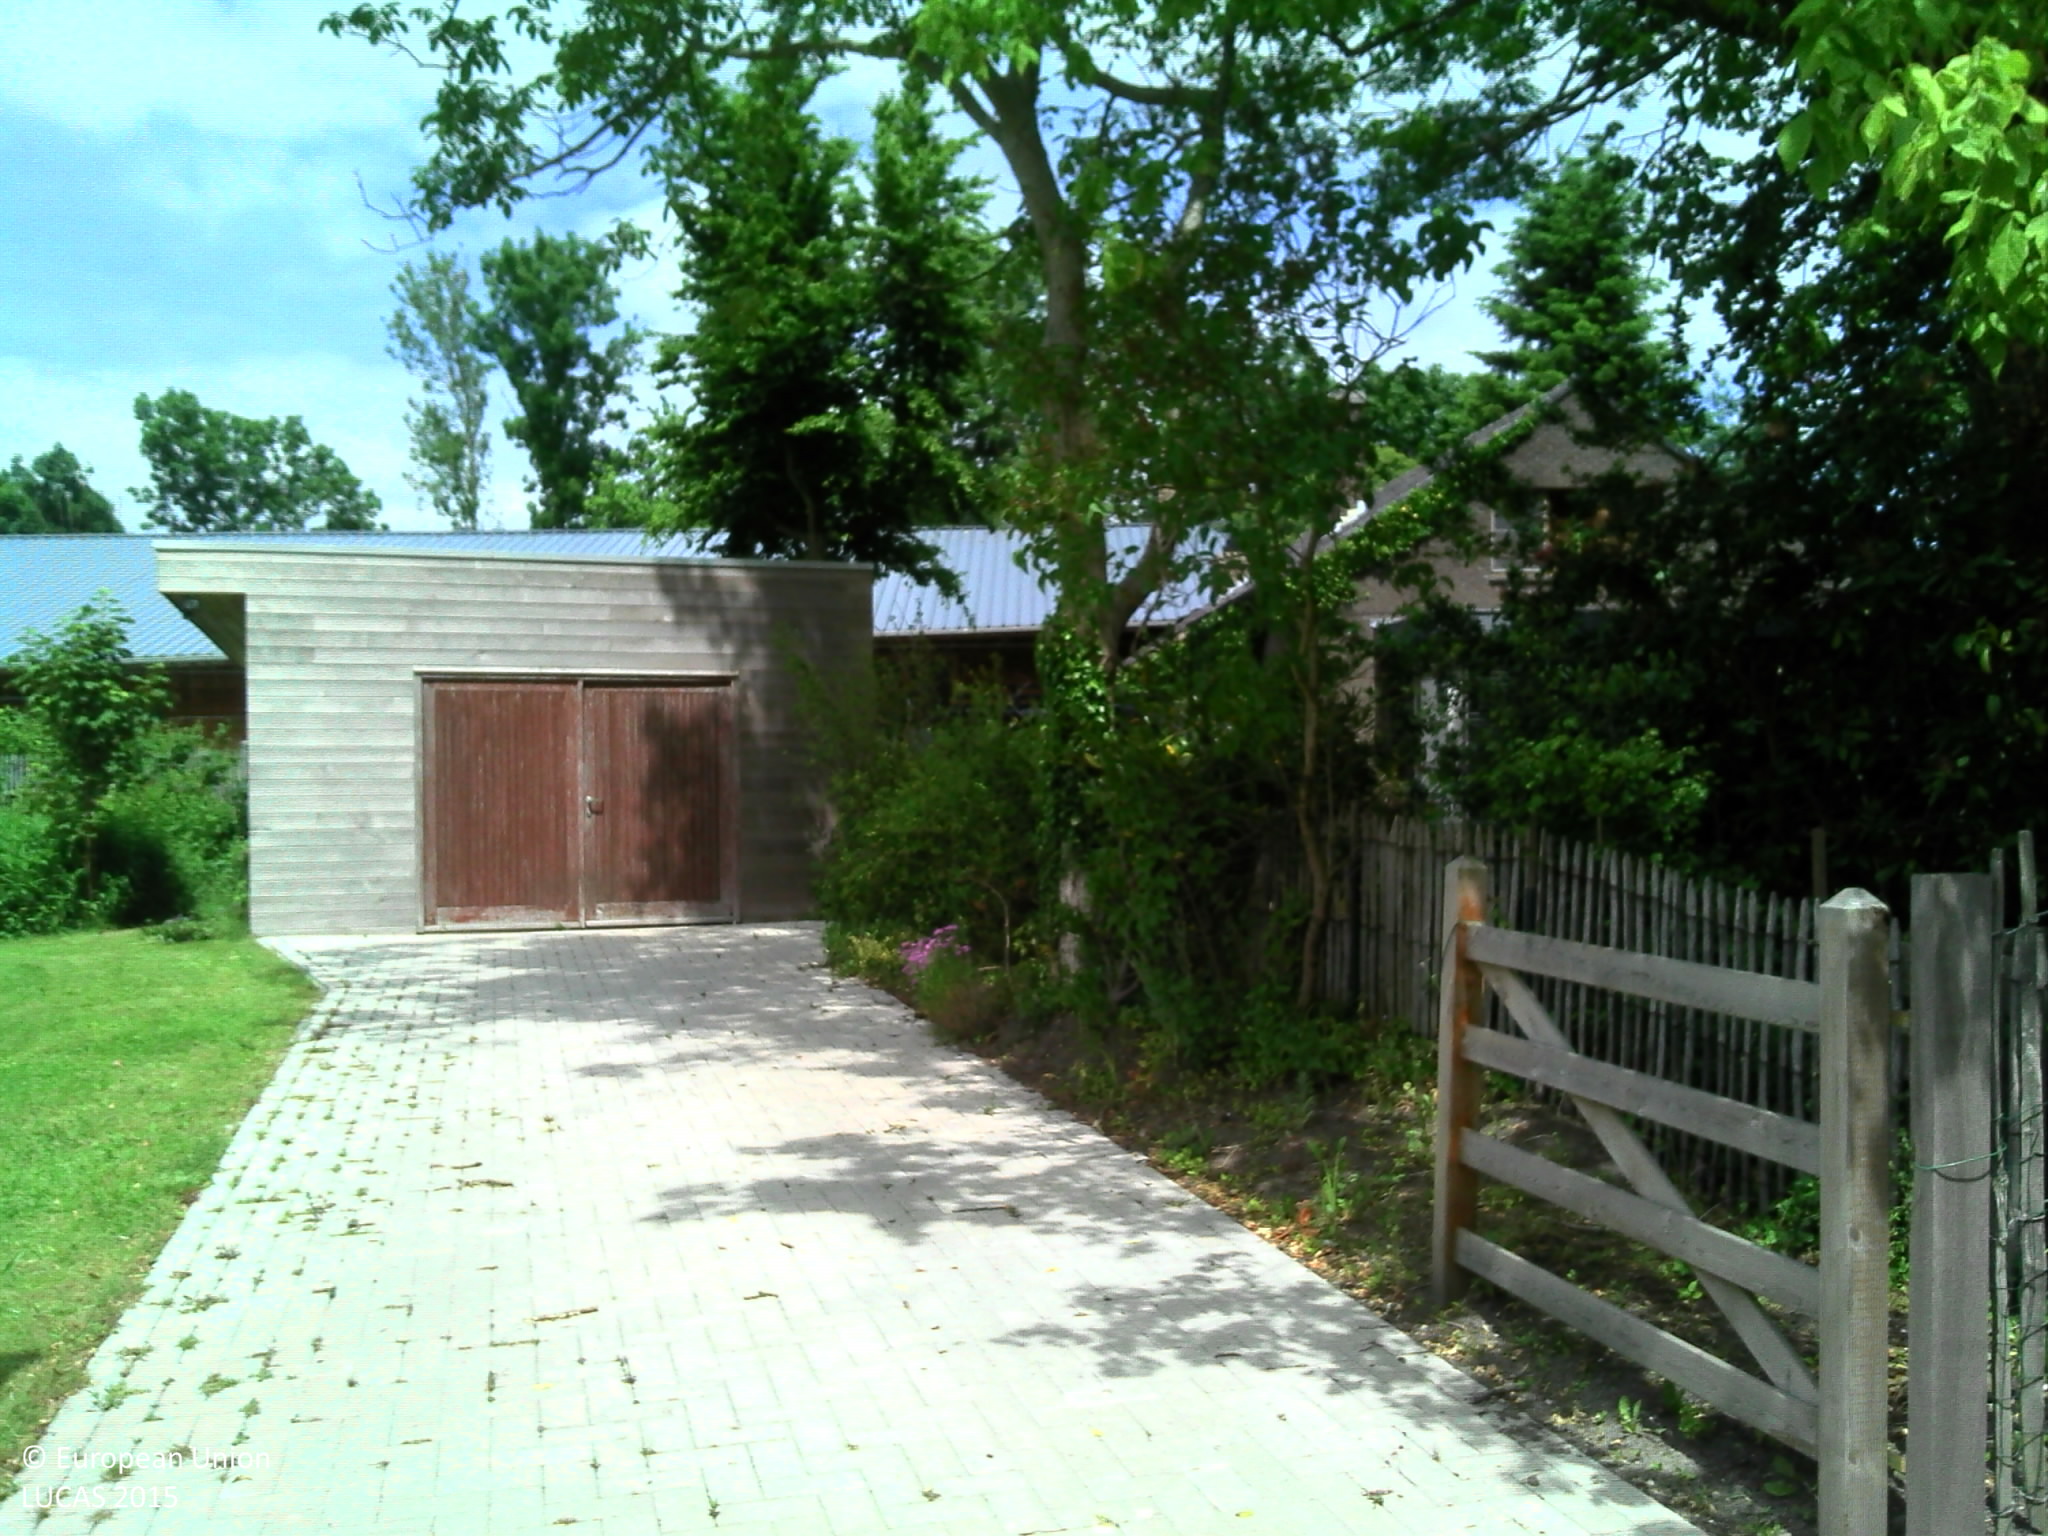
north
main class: Grassland
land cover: Grassland with sparse tree/shrub cover
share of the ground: > 75 %
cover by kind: herbaceous plants 95 %, broadleaved forest trees 5 %
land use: Residential
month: June
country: BE
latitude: 51.2304
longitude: 4.2810
